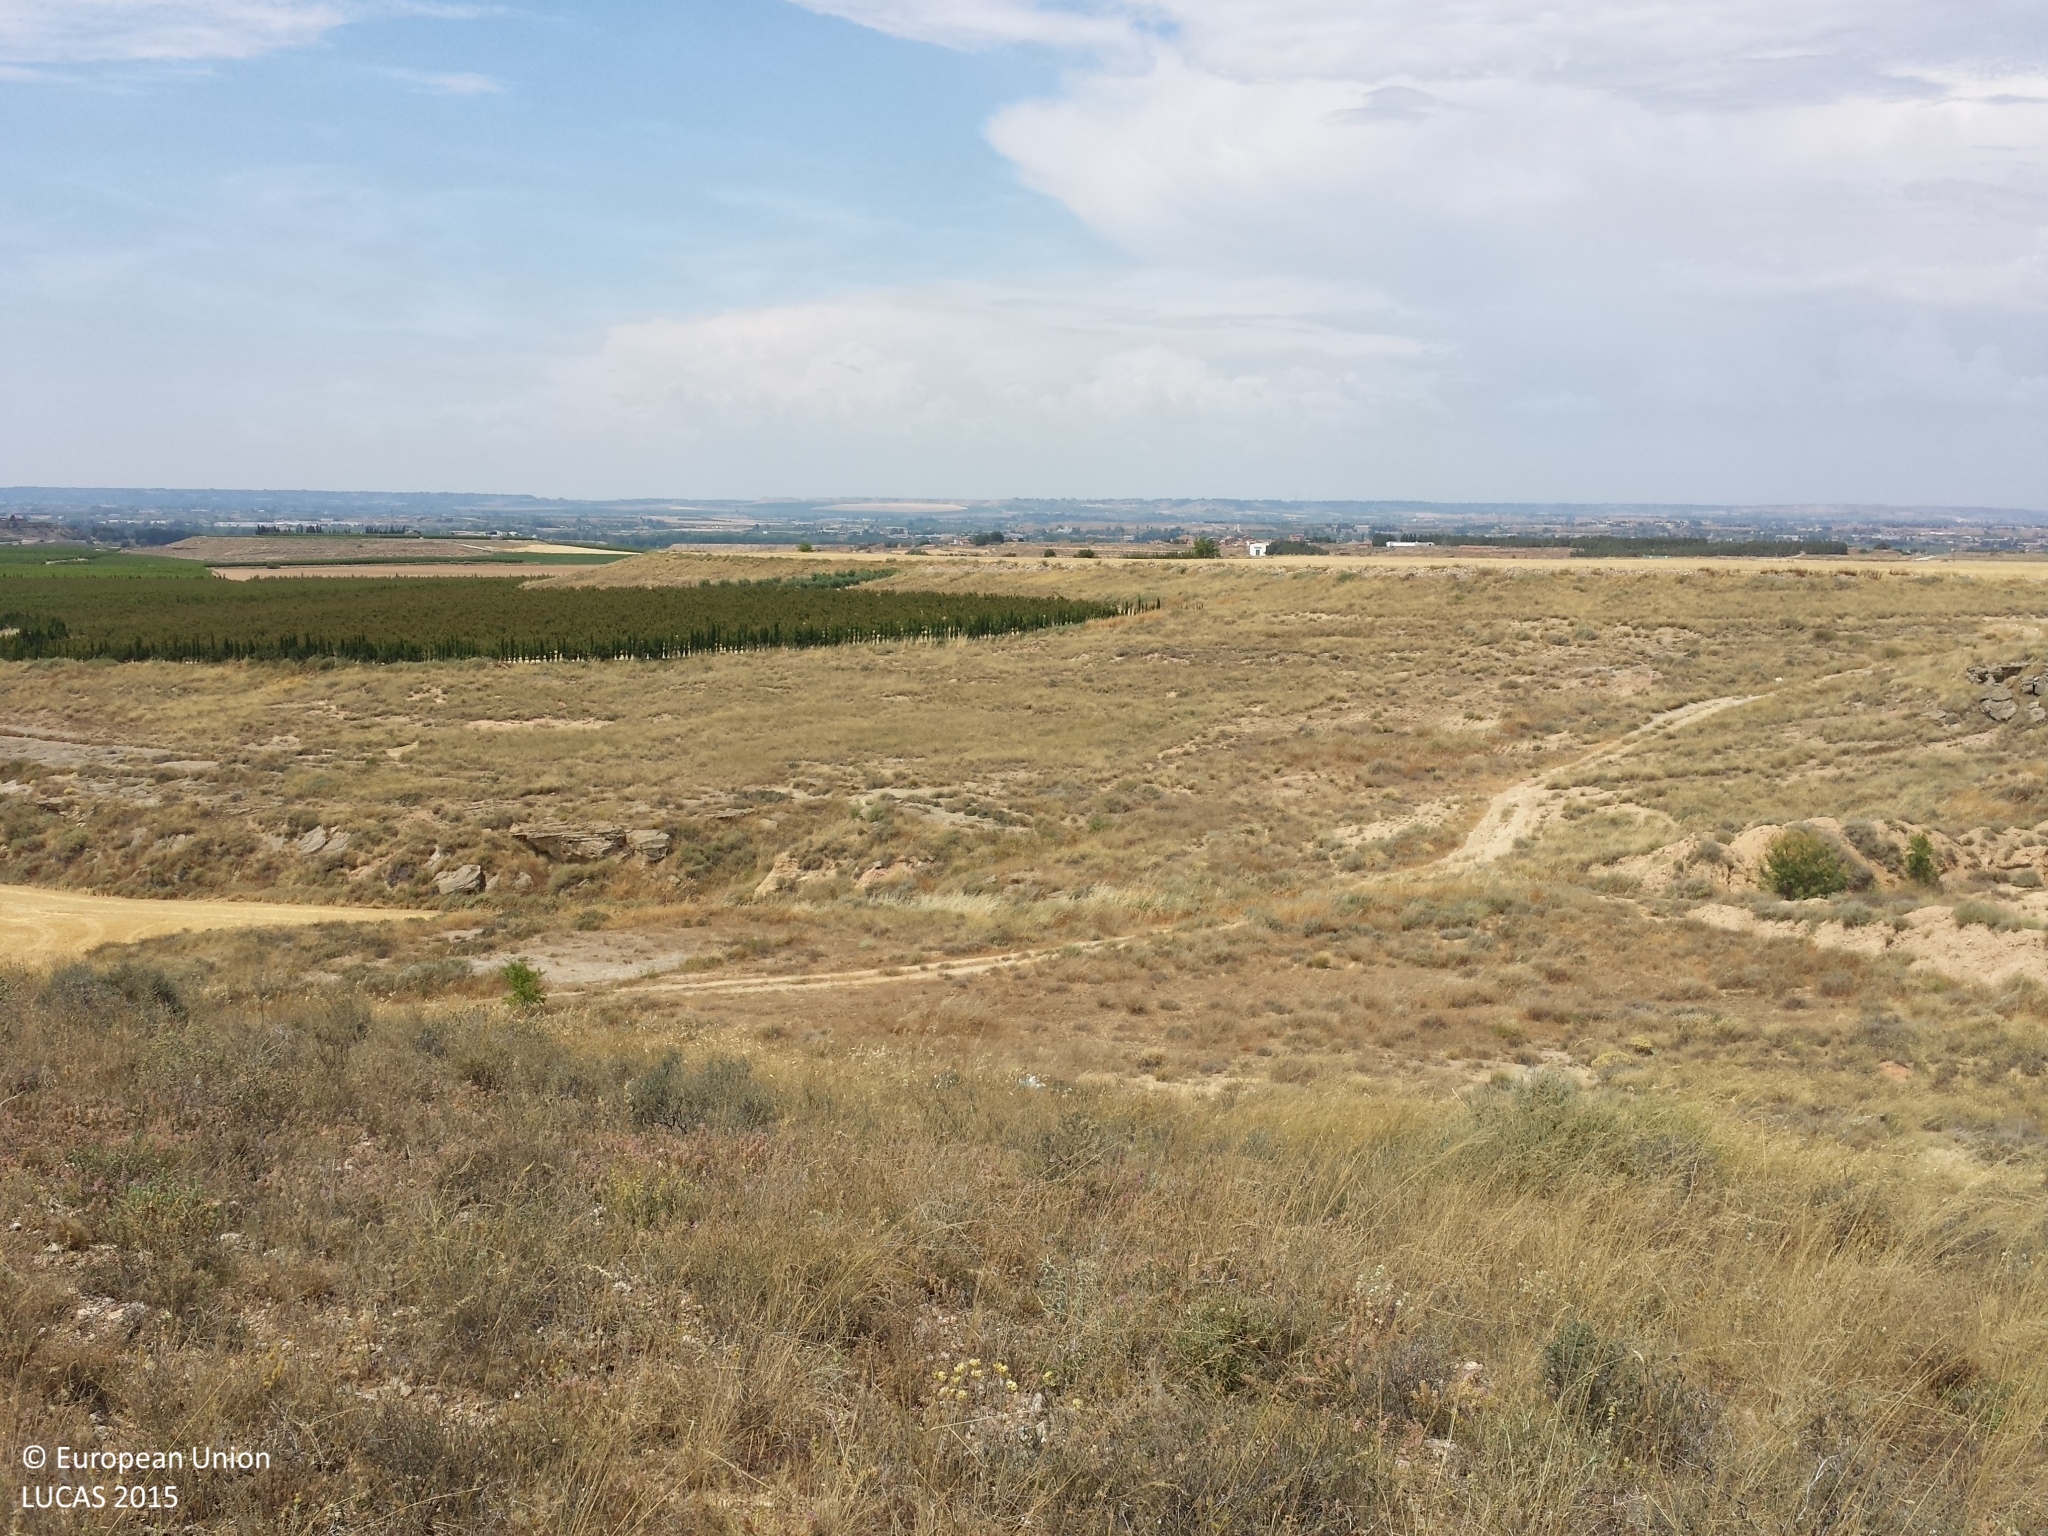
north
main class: Shrubland
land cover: Shrubland without tree cover
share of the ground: > 75 %
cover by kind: shrubs 75 %, herbaceous plants 20 %, consolidated bare surface 5 %
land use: Abandoned areas
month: June
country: ES
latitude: 41.5437
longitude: 0.6019
